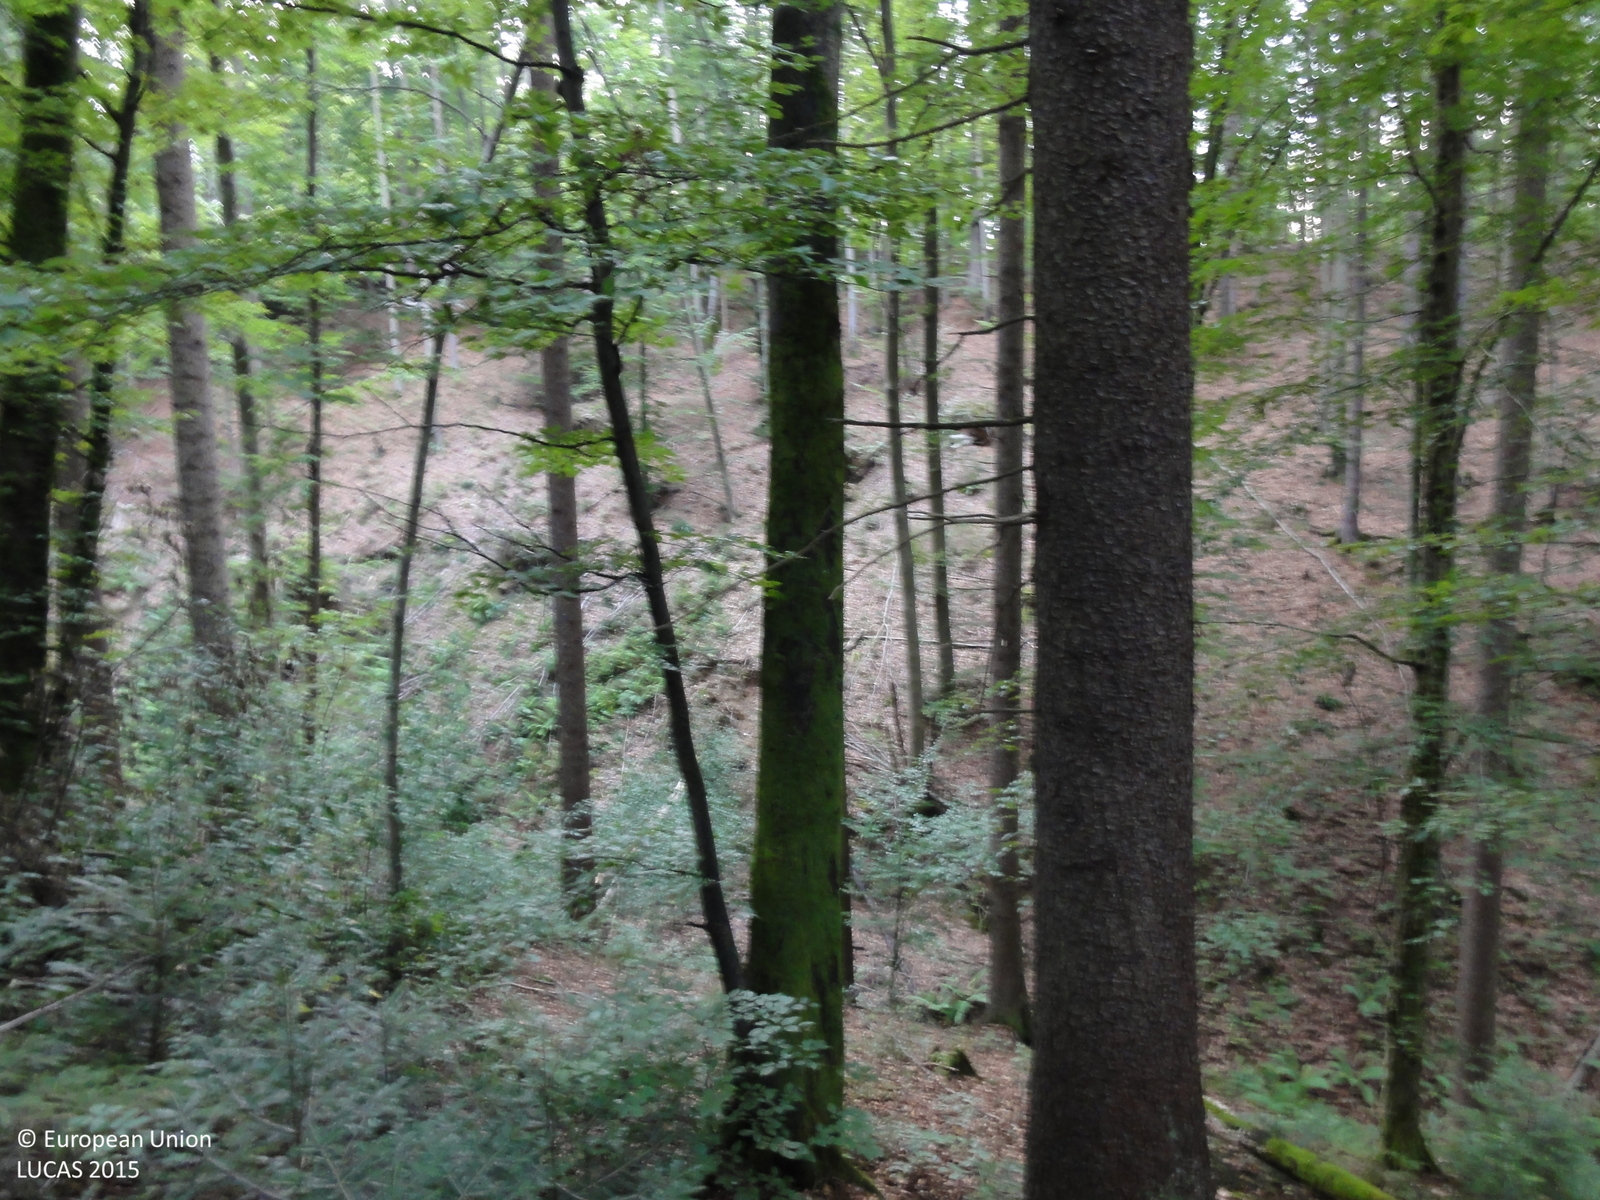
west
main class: Woodland
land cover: Spruce dominated mixed woodland
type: mountainous beech forest
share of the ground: > 75 %
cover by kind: broadleaved forest trees 60 %, coniferous forest trees 30 %, shrubs 5 %, unconsolidated bare surface 5 %
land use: Forestry
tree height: > 5 m
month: August
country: SI
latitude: 46.0790
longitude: 14.8459
